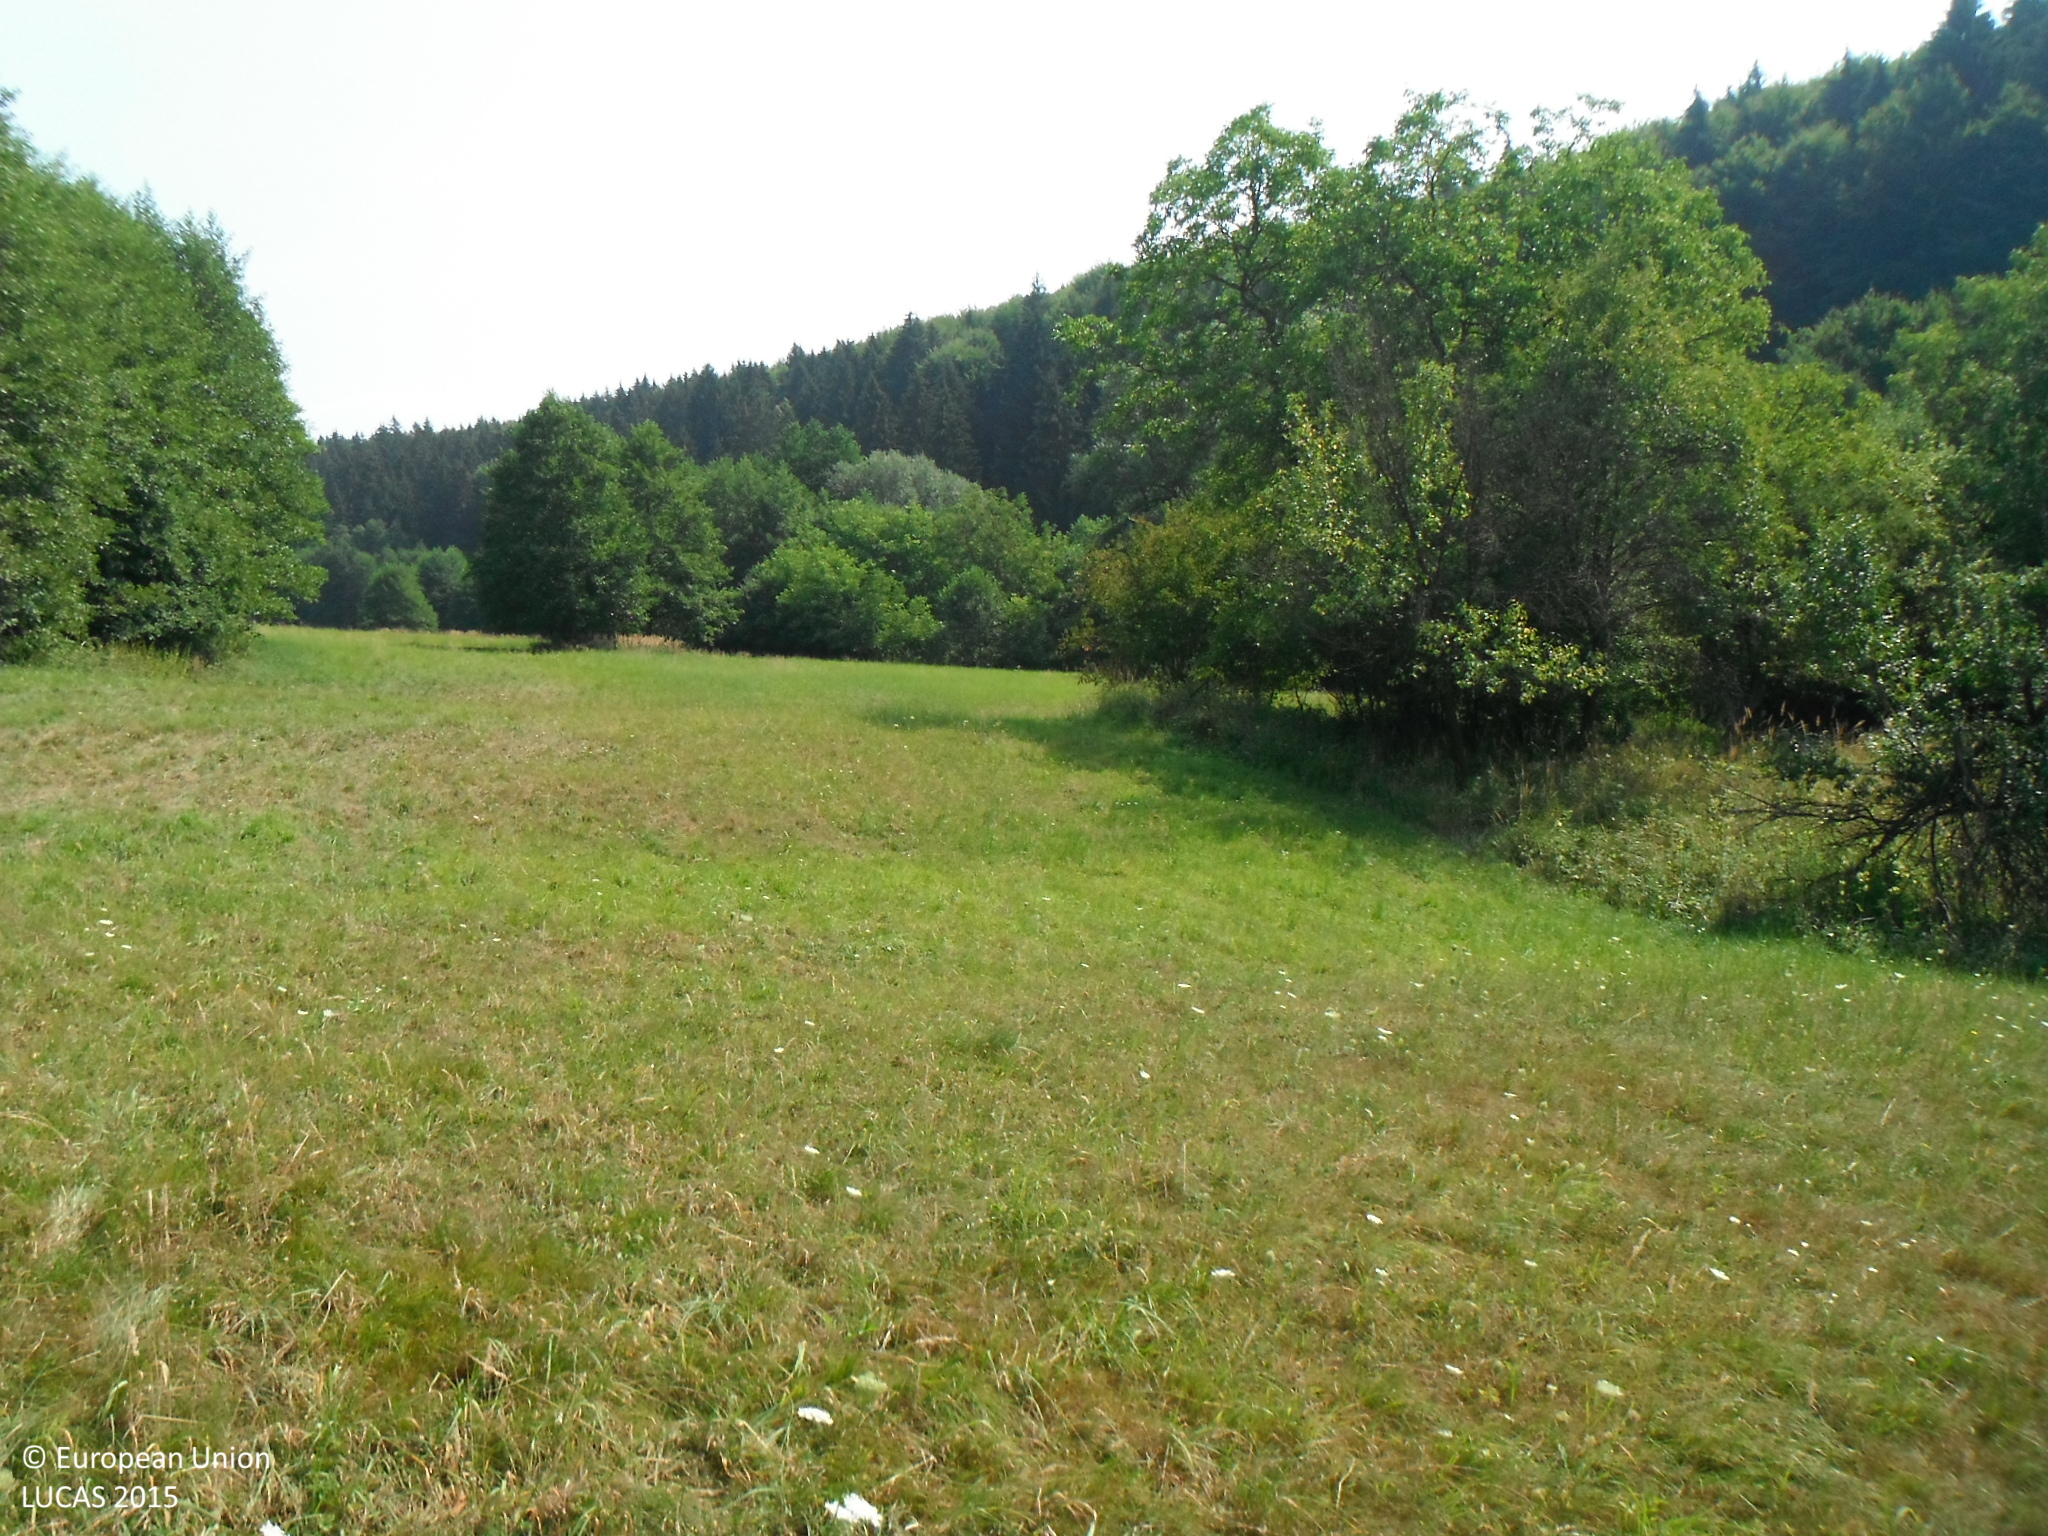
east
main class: Grassland
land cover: Grassland without tree/shrub cover
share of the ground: > 75 %
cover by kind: herbaceous plants 100 %
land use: Agriculture (excluding fallow land and kitchen gardens)
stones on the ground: < 10 %
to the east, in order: Grassland without tree/shrub cover; Broadleaved woodland; Grassland without tree/shrub cover; Broadleaved woodland; Rivers and streams; Broadleaved woodland; Spontaneously vegetated surfaces; Tracks; Grass margins; Spruce dominated coniferous woodland; Broadleaved woodland
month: August
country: SK
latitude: 49.0796
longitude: 18.3821
